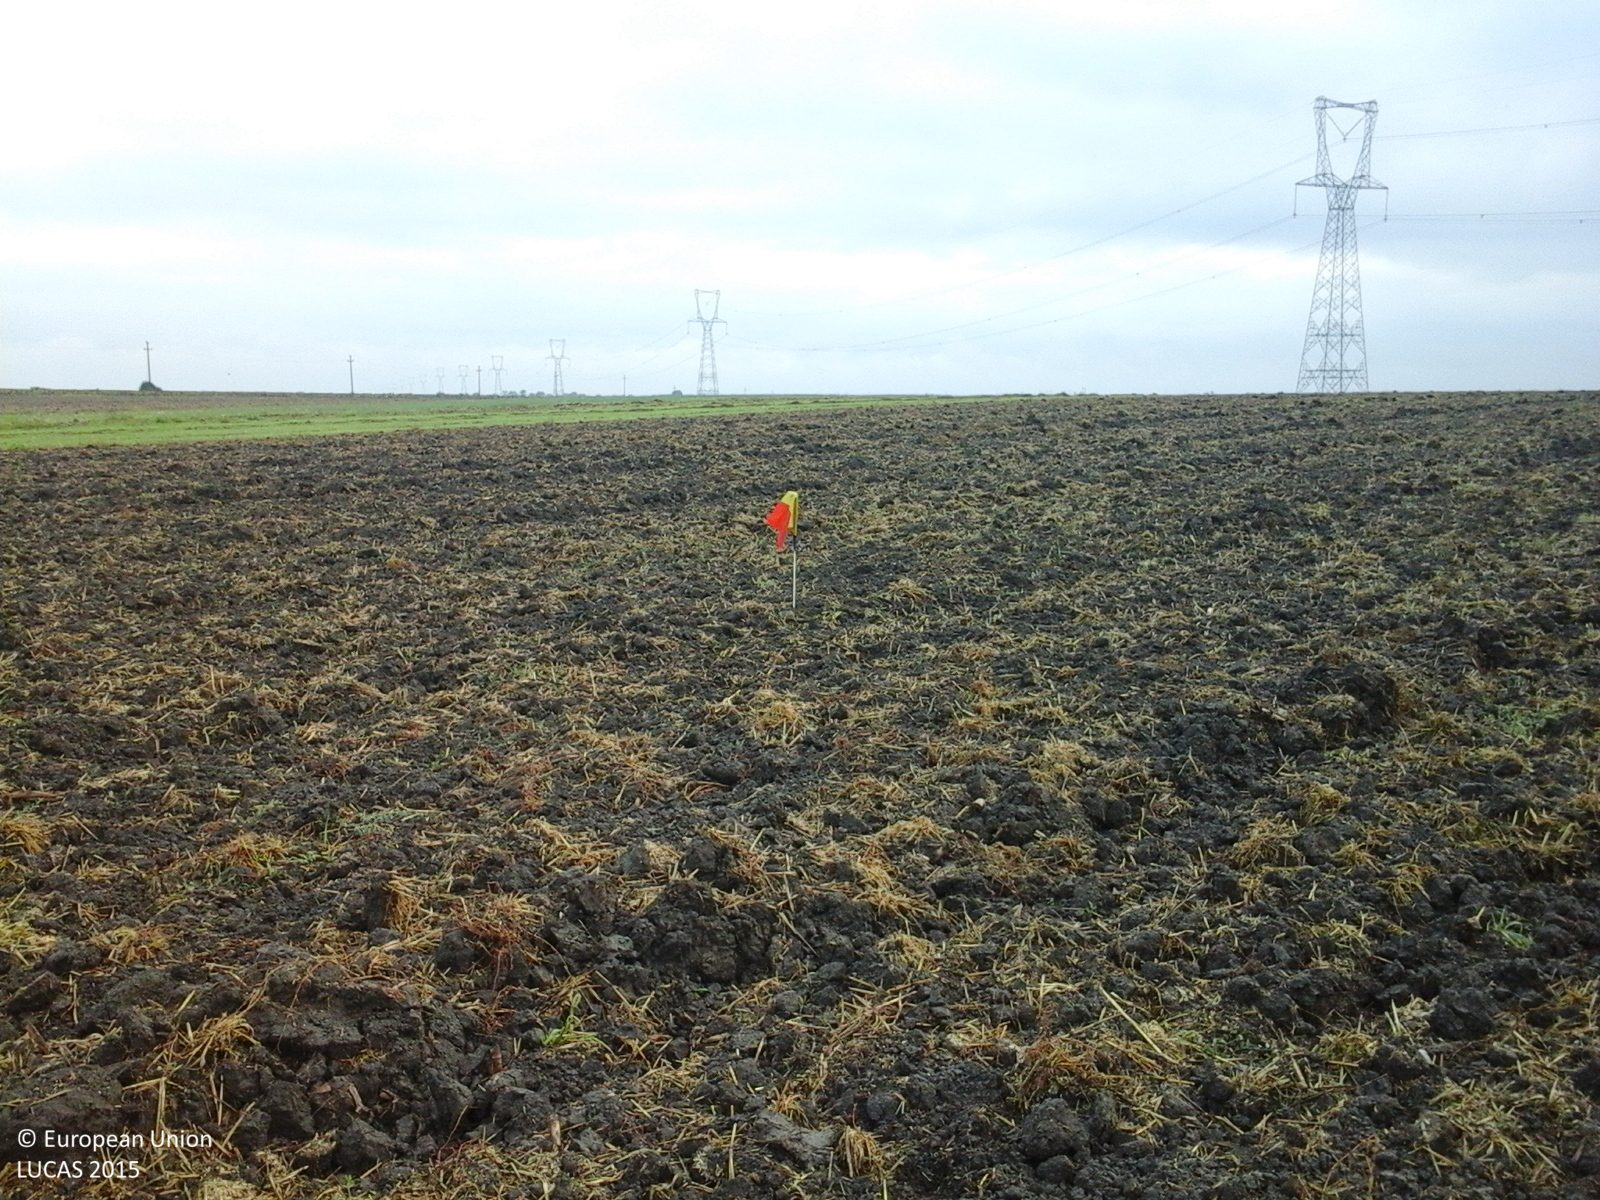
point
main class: Cropland
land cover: Common wheat
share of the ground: < 10 %
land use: Agriculture (excluding fallow land and kitchen gardens)
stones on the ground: < 10 %
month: September
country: RO
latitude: 46.8318
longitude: 21.7235
